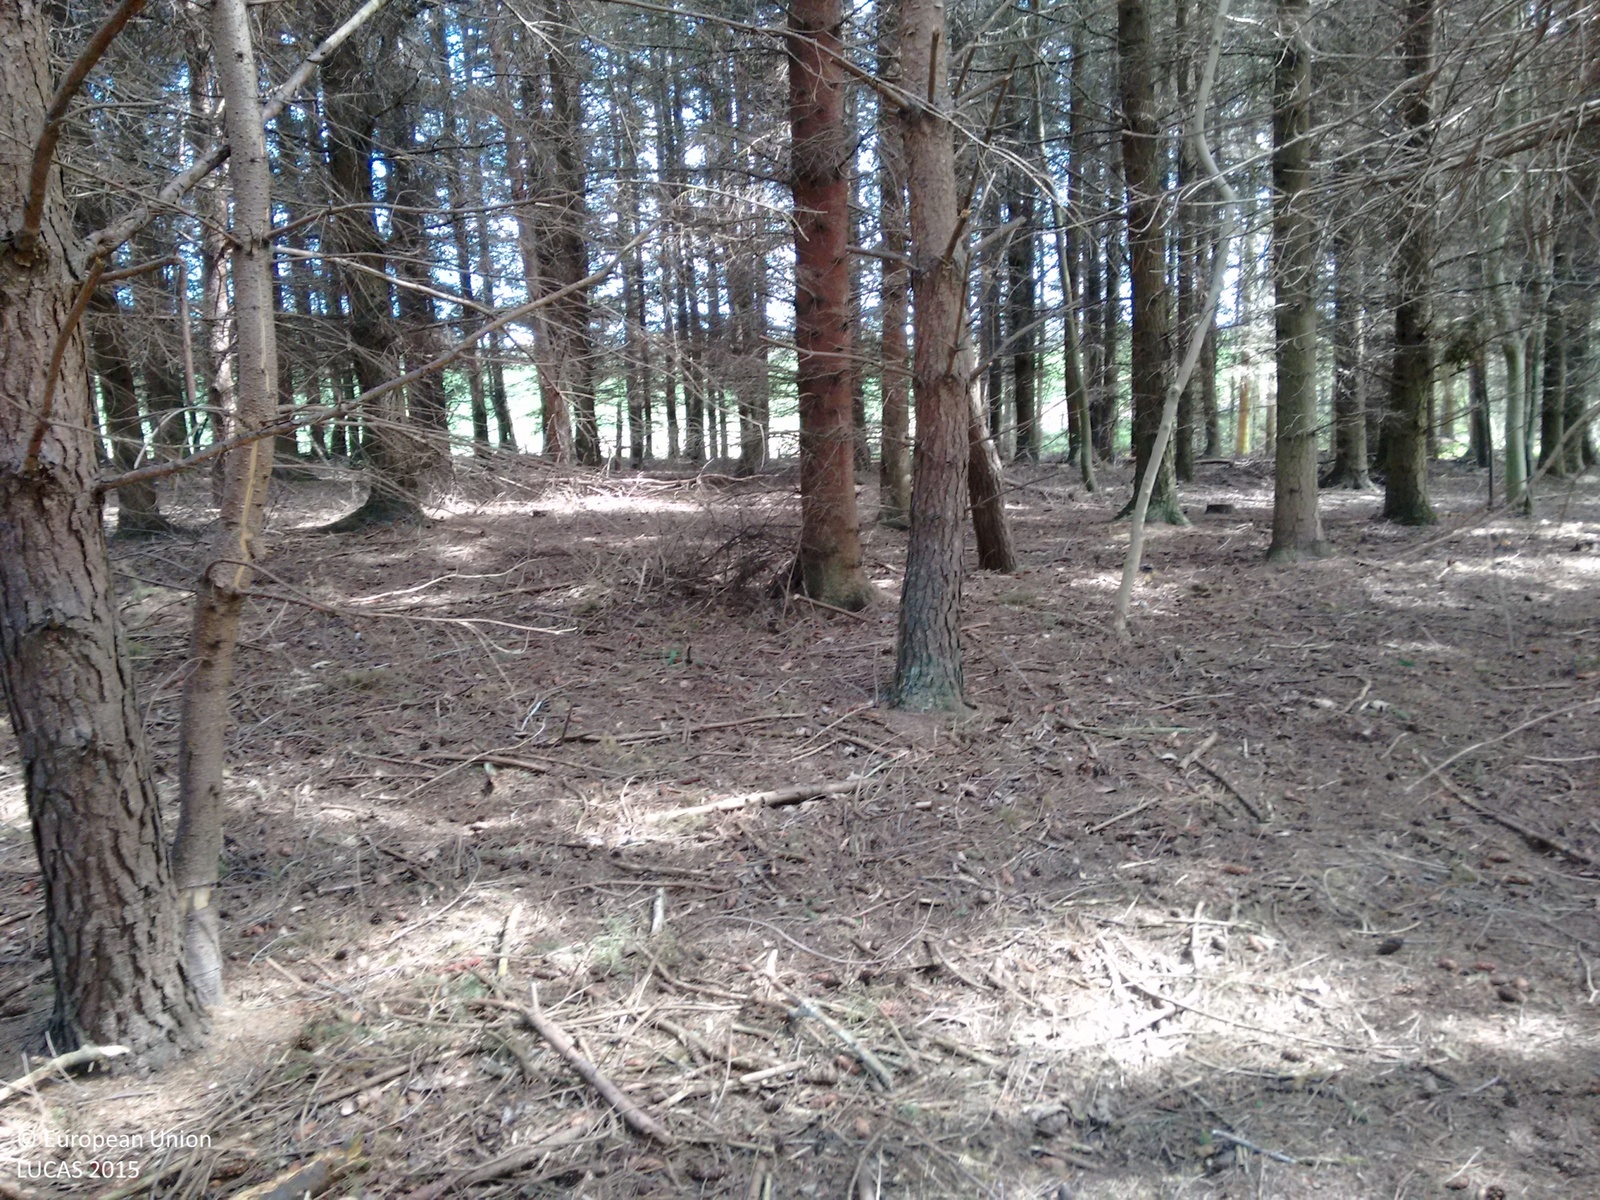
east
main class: Woodland
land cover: Pine dominated coniferous woodland
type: exotic forest
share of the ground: > 75 %
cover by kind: coniferous forest trees 100 %
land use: Forestry
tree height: > 5 m
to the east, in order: Pine dominated coniferous woodland; Fences; Barley; Fences; Shruby margins; Grass margins; Paved roads, cycling and walking lanes; Grass margins; Shruby margins; Fences; Barley
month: May
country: GB
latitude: 55.3234
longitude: -1.6959
